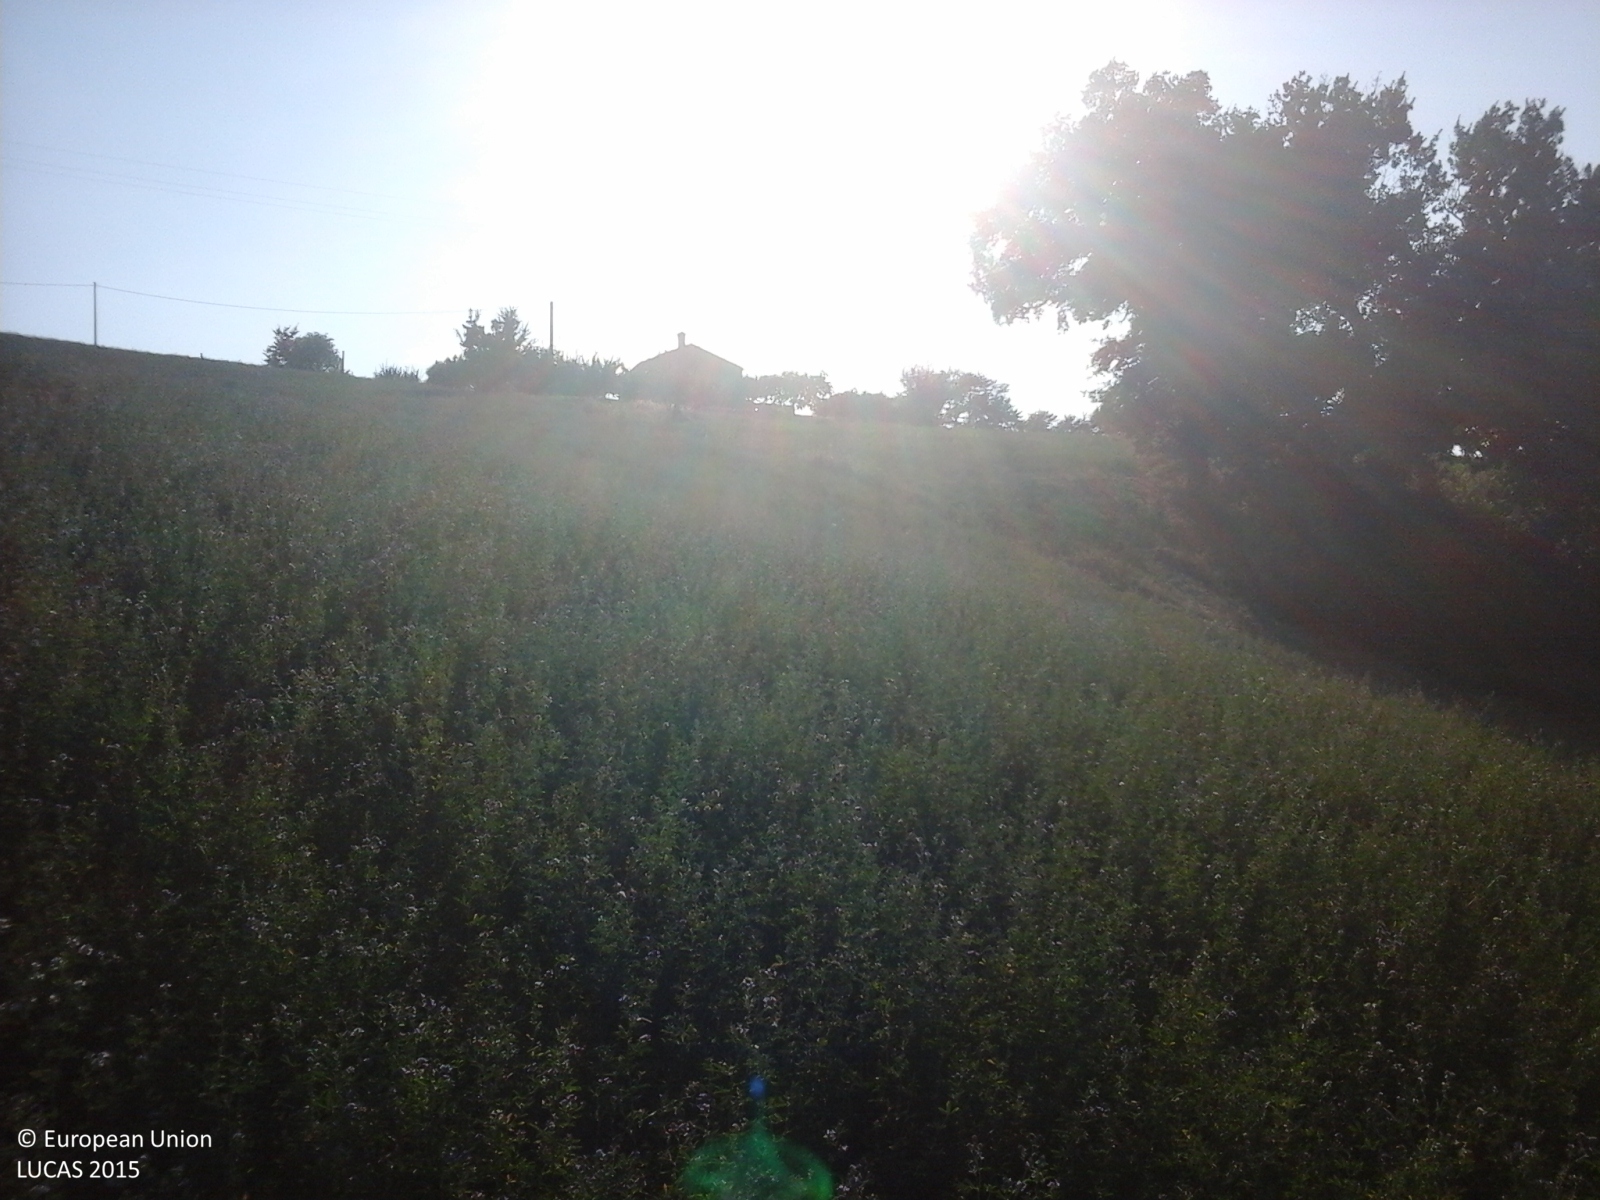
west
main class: Cropland
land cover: Lucerne
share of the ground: > 75 %
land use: Agriculture (excluding fallow land and kitchen gardens)
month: July
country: IT
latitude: 43.1753
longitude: 13.3986
